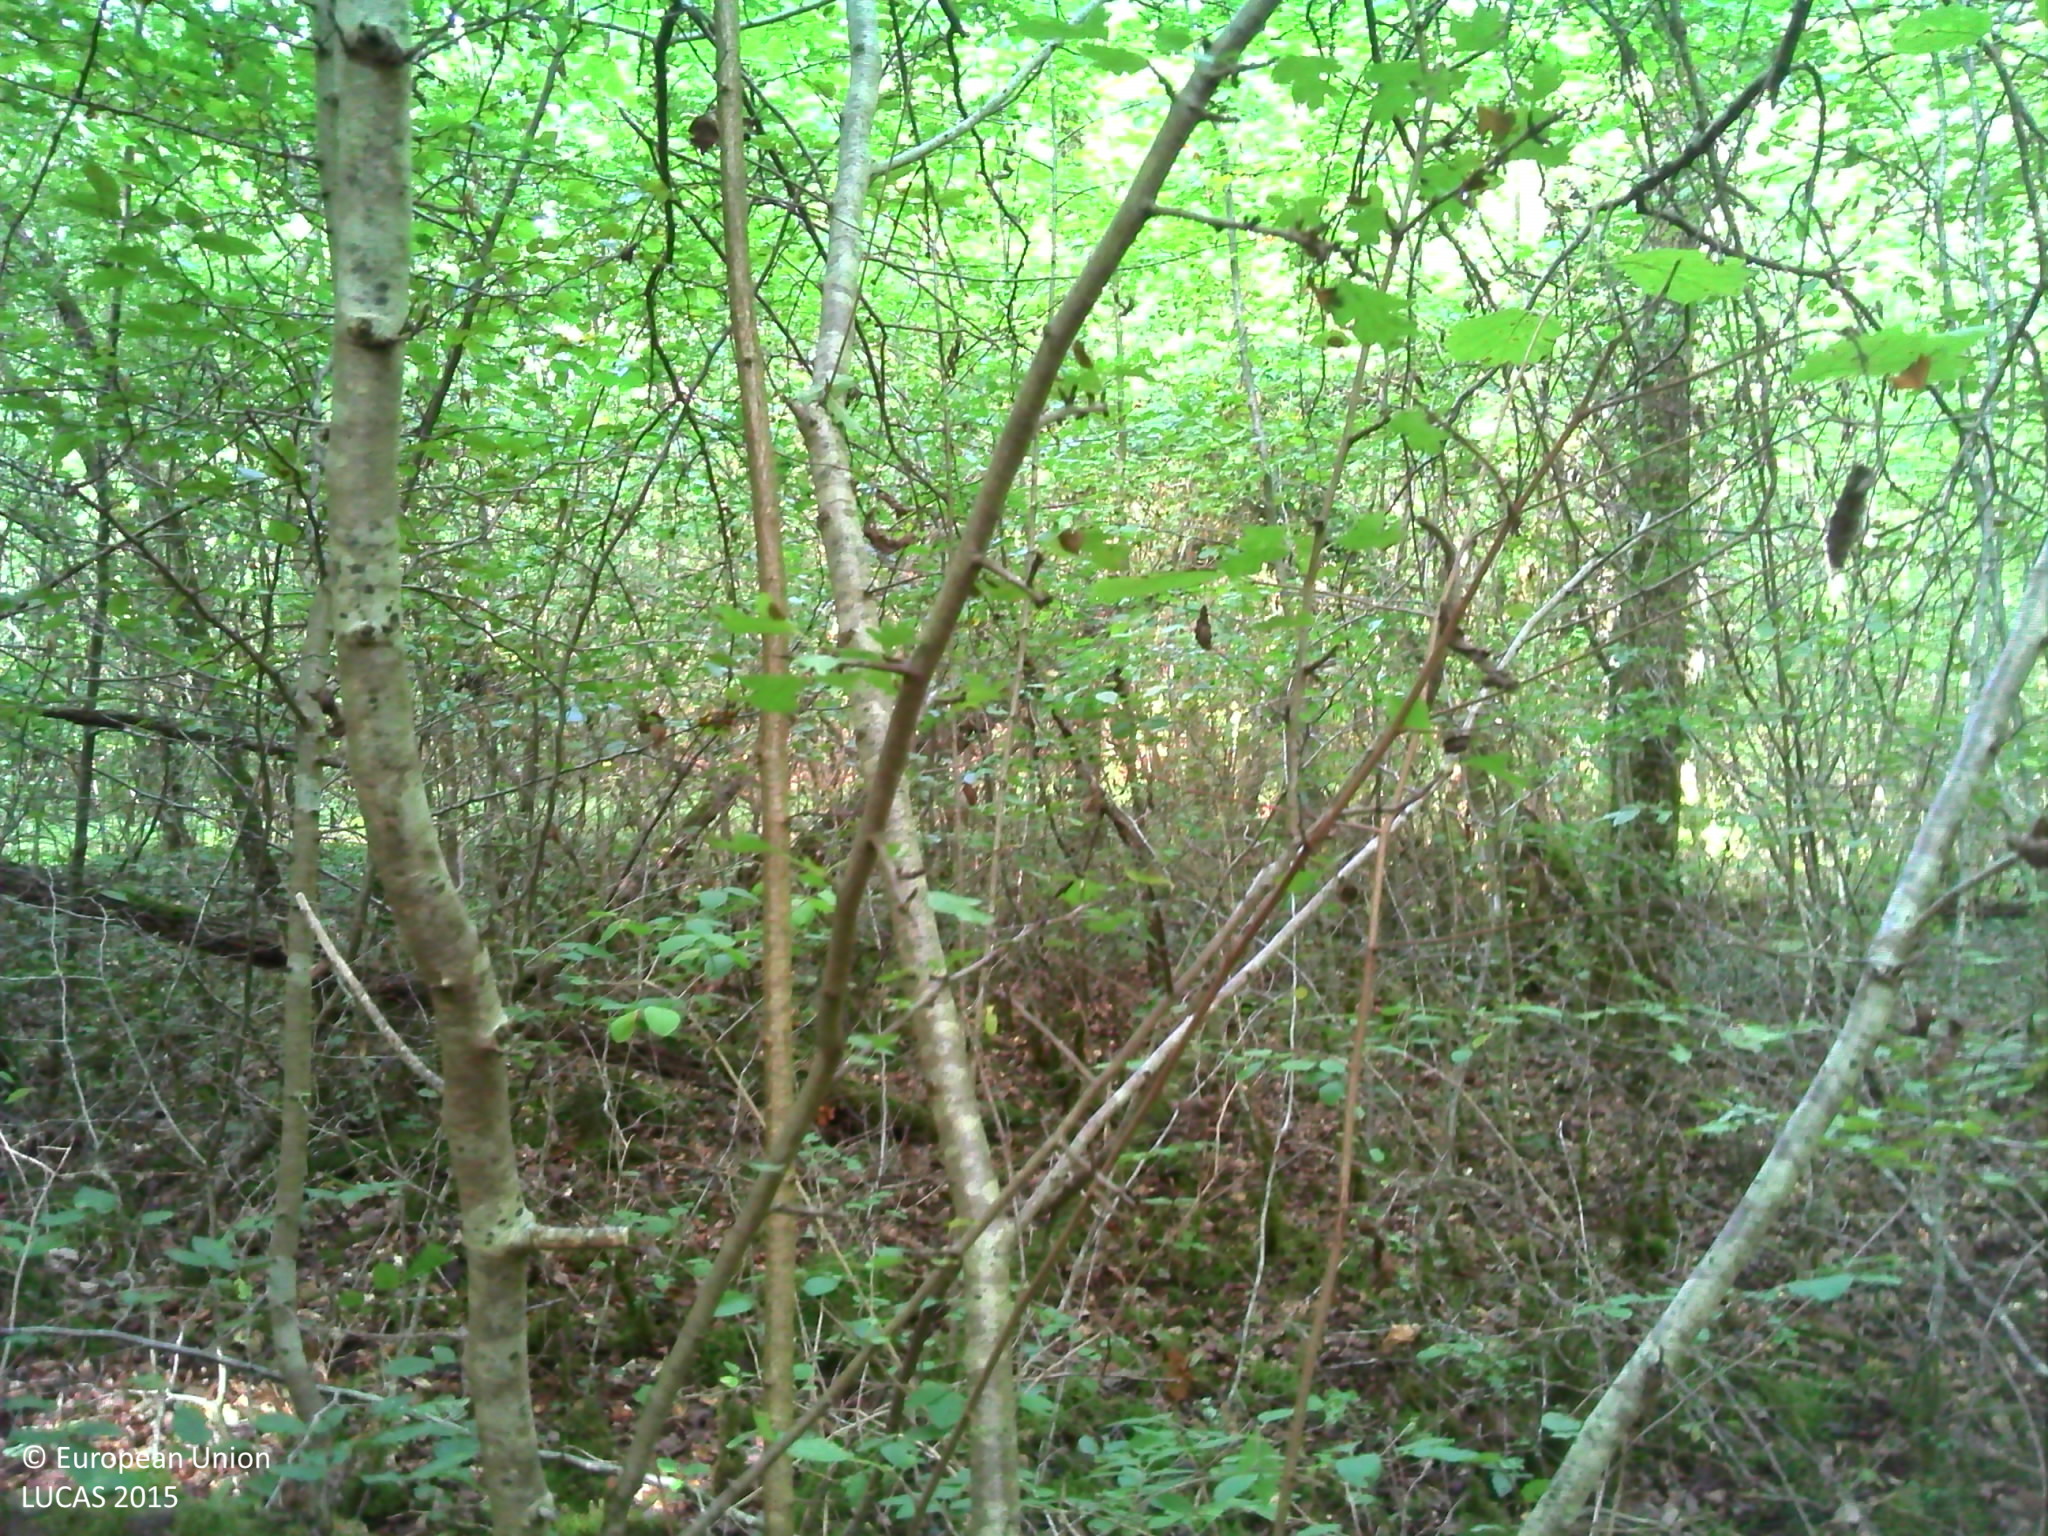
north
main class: Woodland
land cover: Broadleaved woodland
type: mesophytic deciduous forest
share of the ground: > 75 %
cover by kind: broadleaved forest trees 80 %, shrubs 10 %, herbaceous plants 10 %
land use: Forestry
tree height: > 5 m
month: September
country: FR
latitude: 48.2580
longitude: 2.7850
